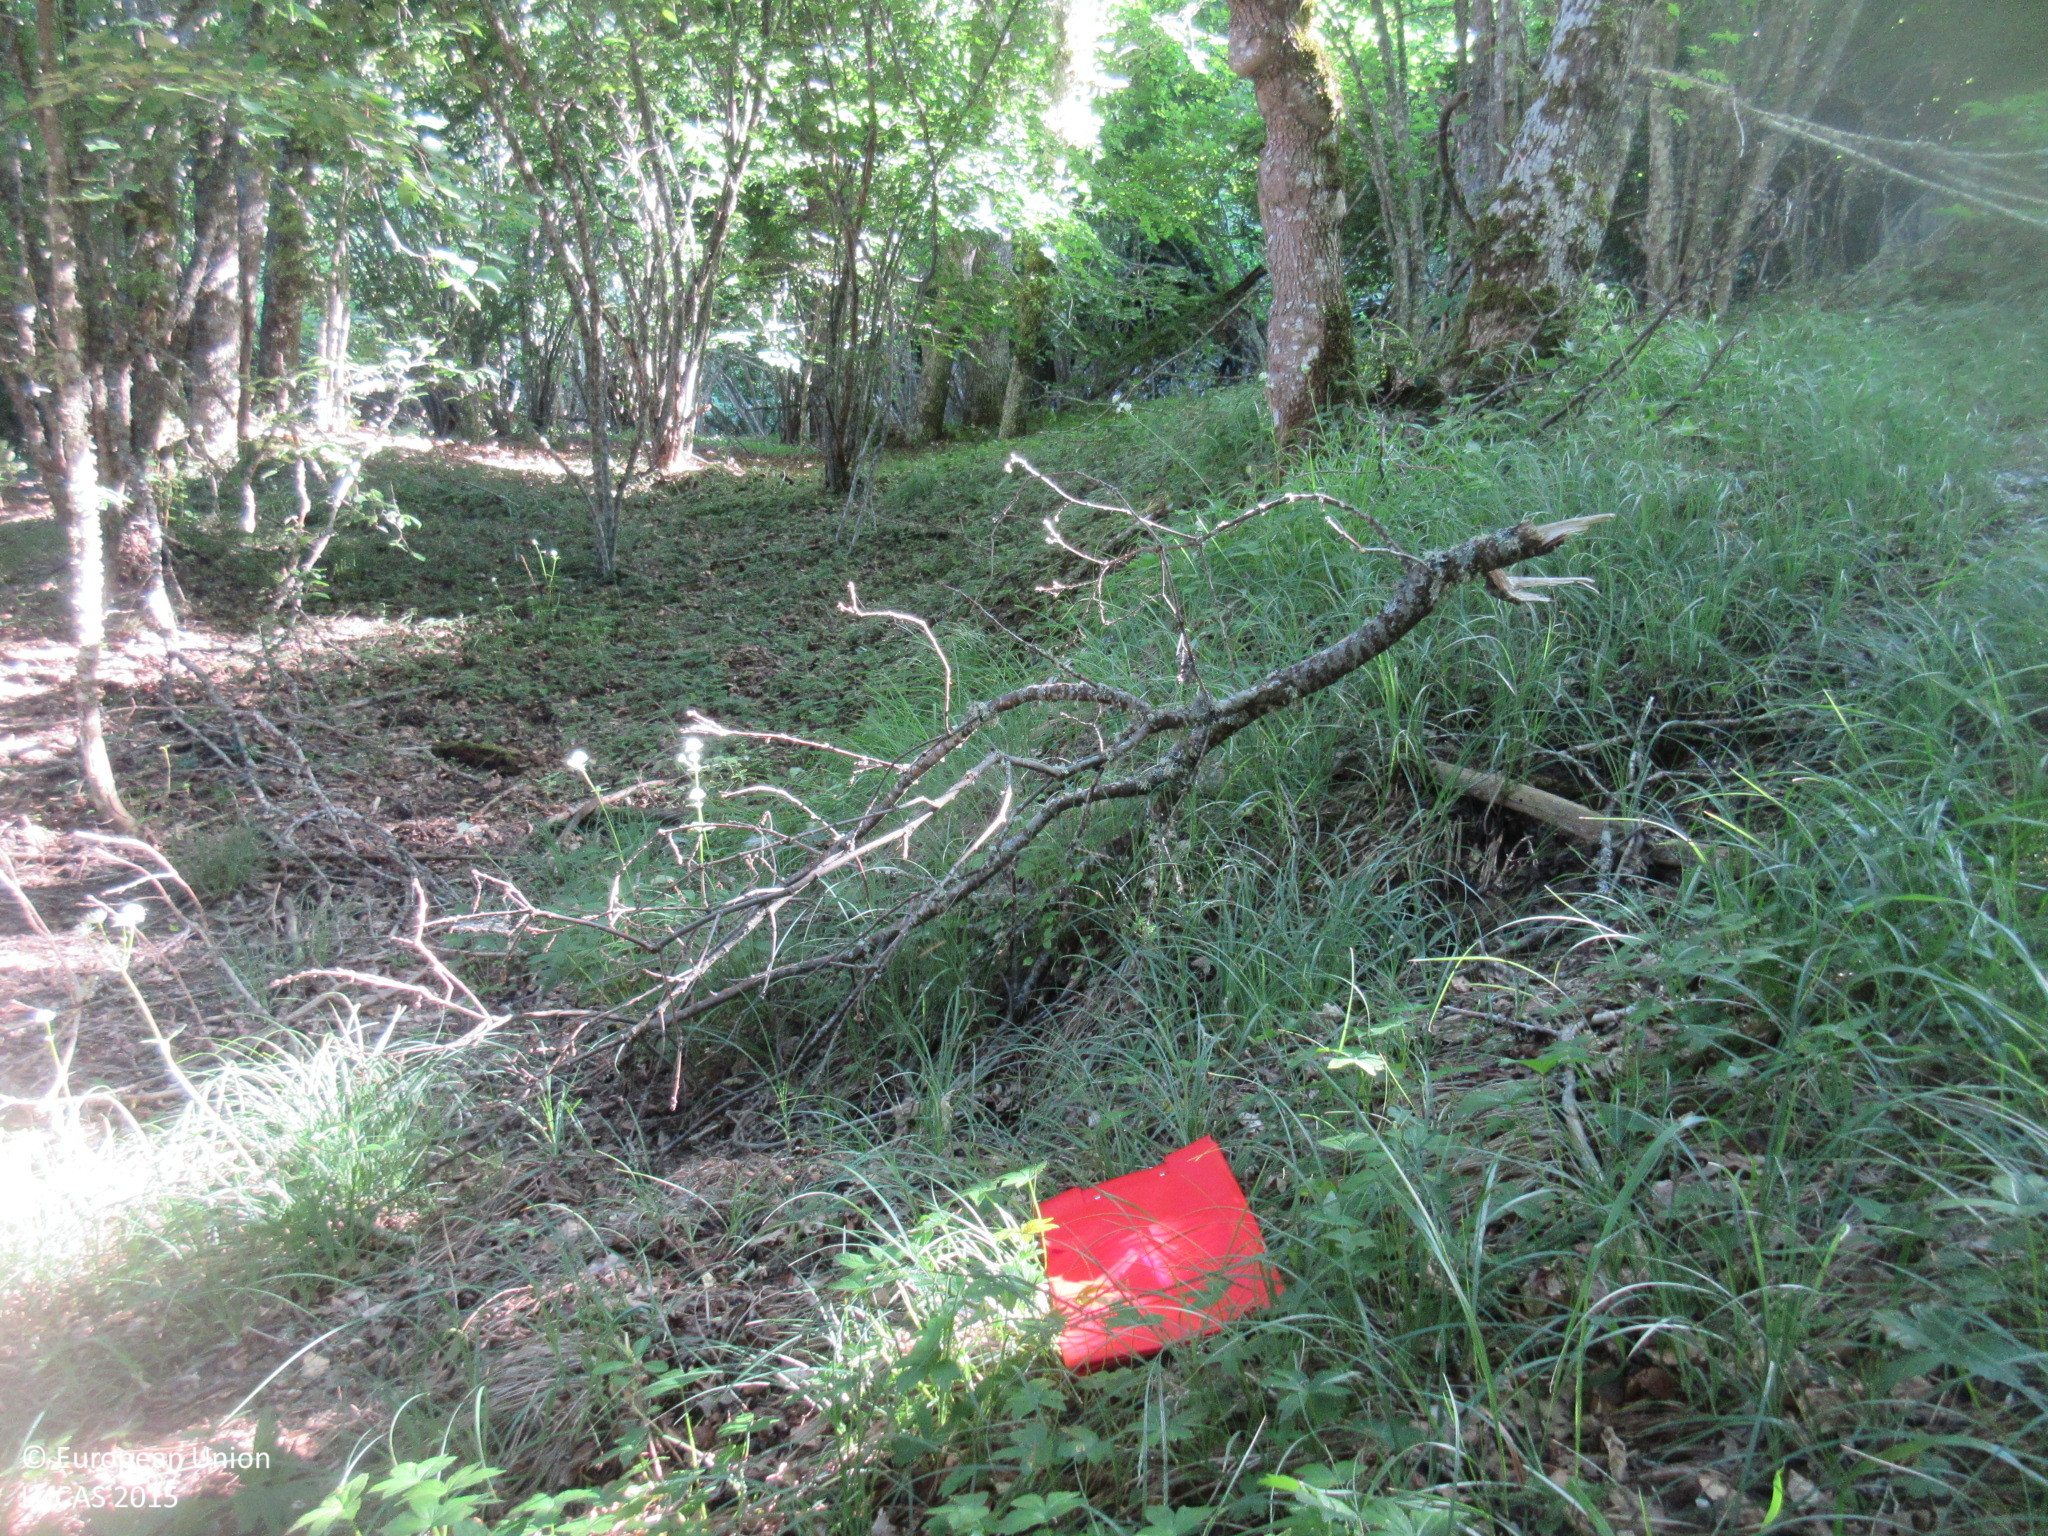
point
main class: Woodland
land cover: Broadleaved woodland
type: thermophilous deciduous forest
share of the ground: > 75 %
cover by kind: broadleaved forest trees 100 %
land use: Semi-natural and natural areas not in use
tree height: > 5 m
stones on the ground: < 10 %
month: July
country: ES
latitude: 42.9260
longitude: -3.8278
